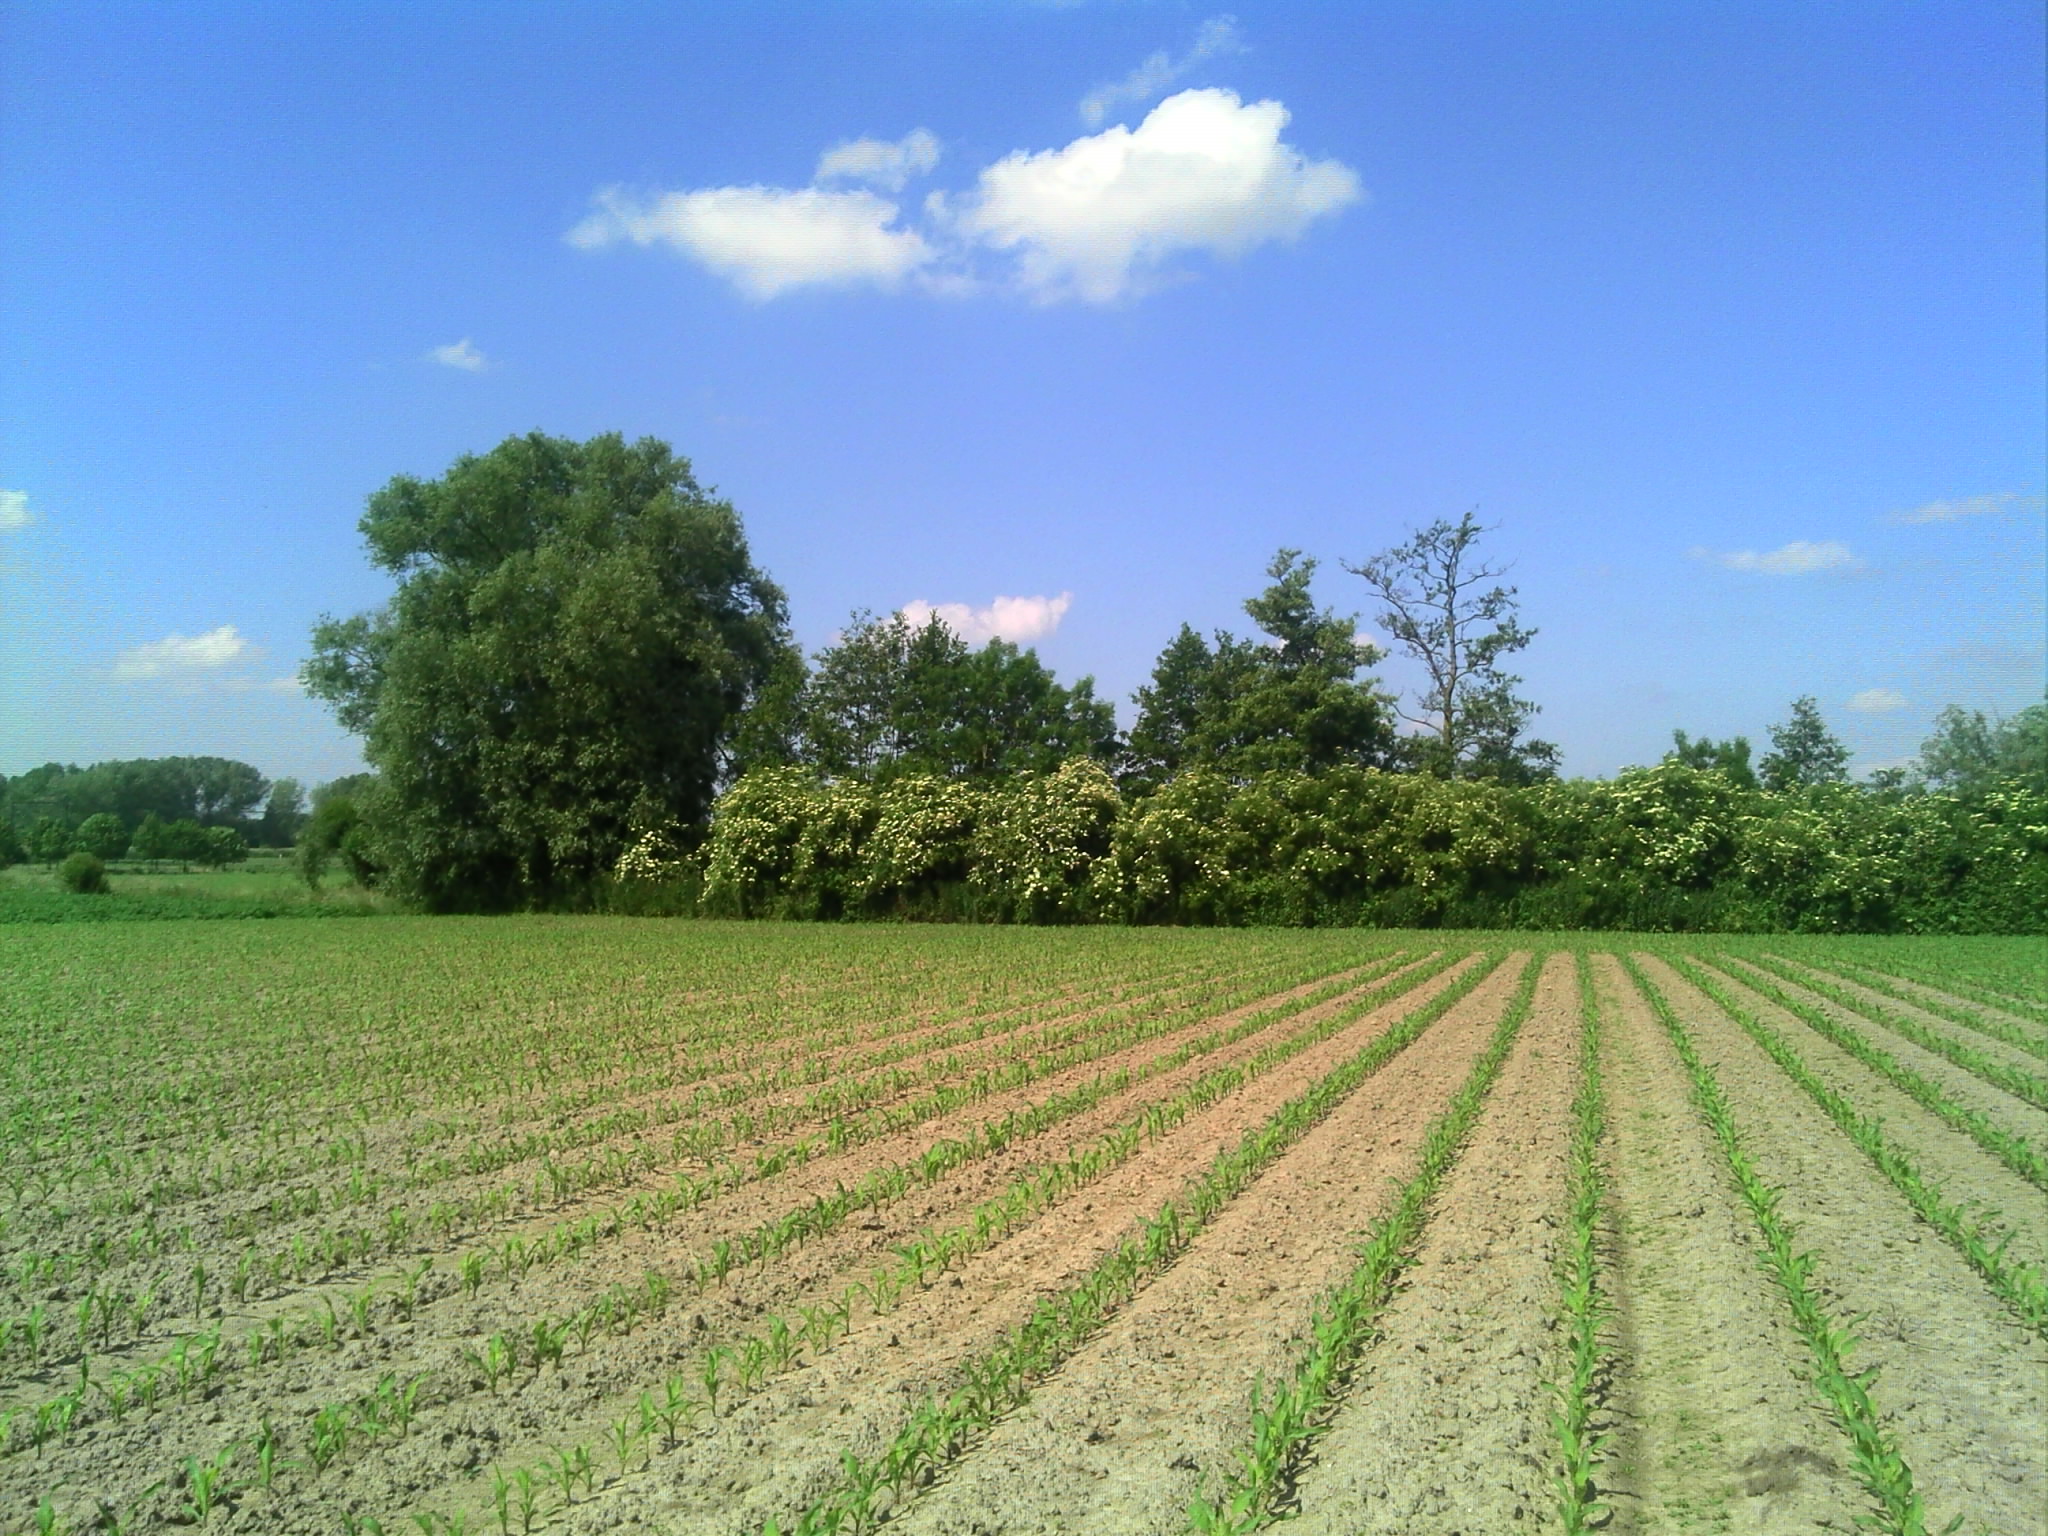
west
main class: Cropland
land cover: Maize
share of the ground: 10 - 25 %
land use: Agriculture (excluding fallow land and kitchen gardens)
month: June
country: BE
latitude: 51.0140
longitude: 4.2792
